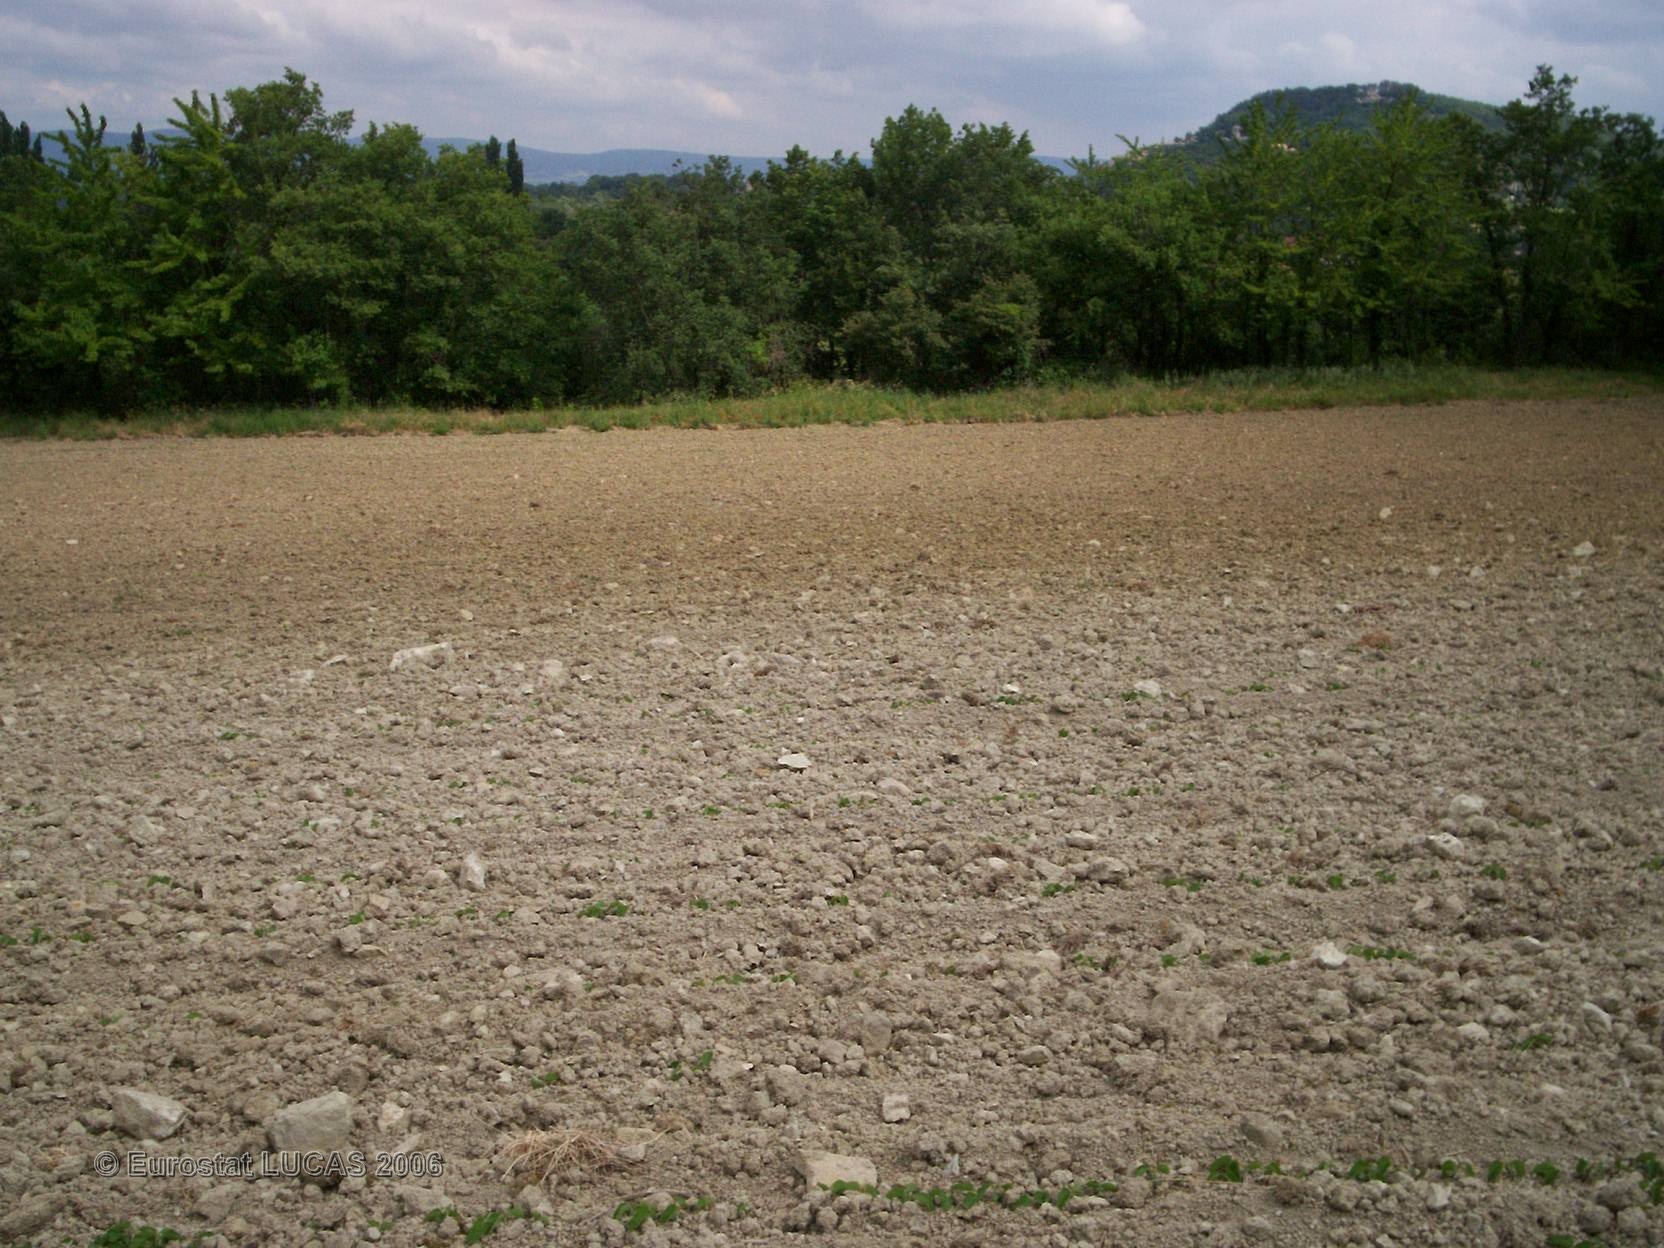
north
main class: Cropland
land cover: Soya
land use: Agriculture (excluding fallow land and kitchen gardens)
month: June
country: FR
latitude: 44.5341
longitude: 4.9354
